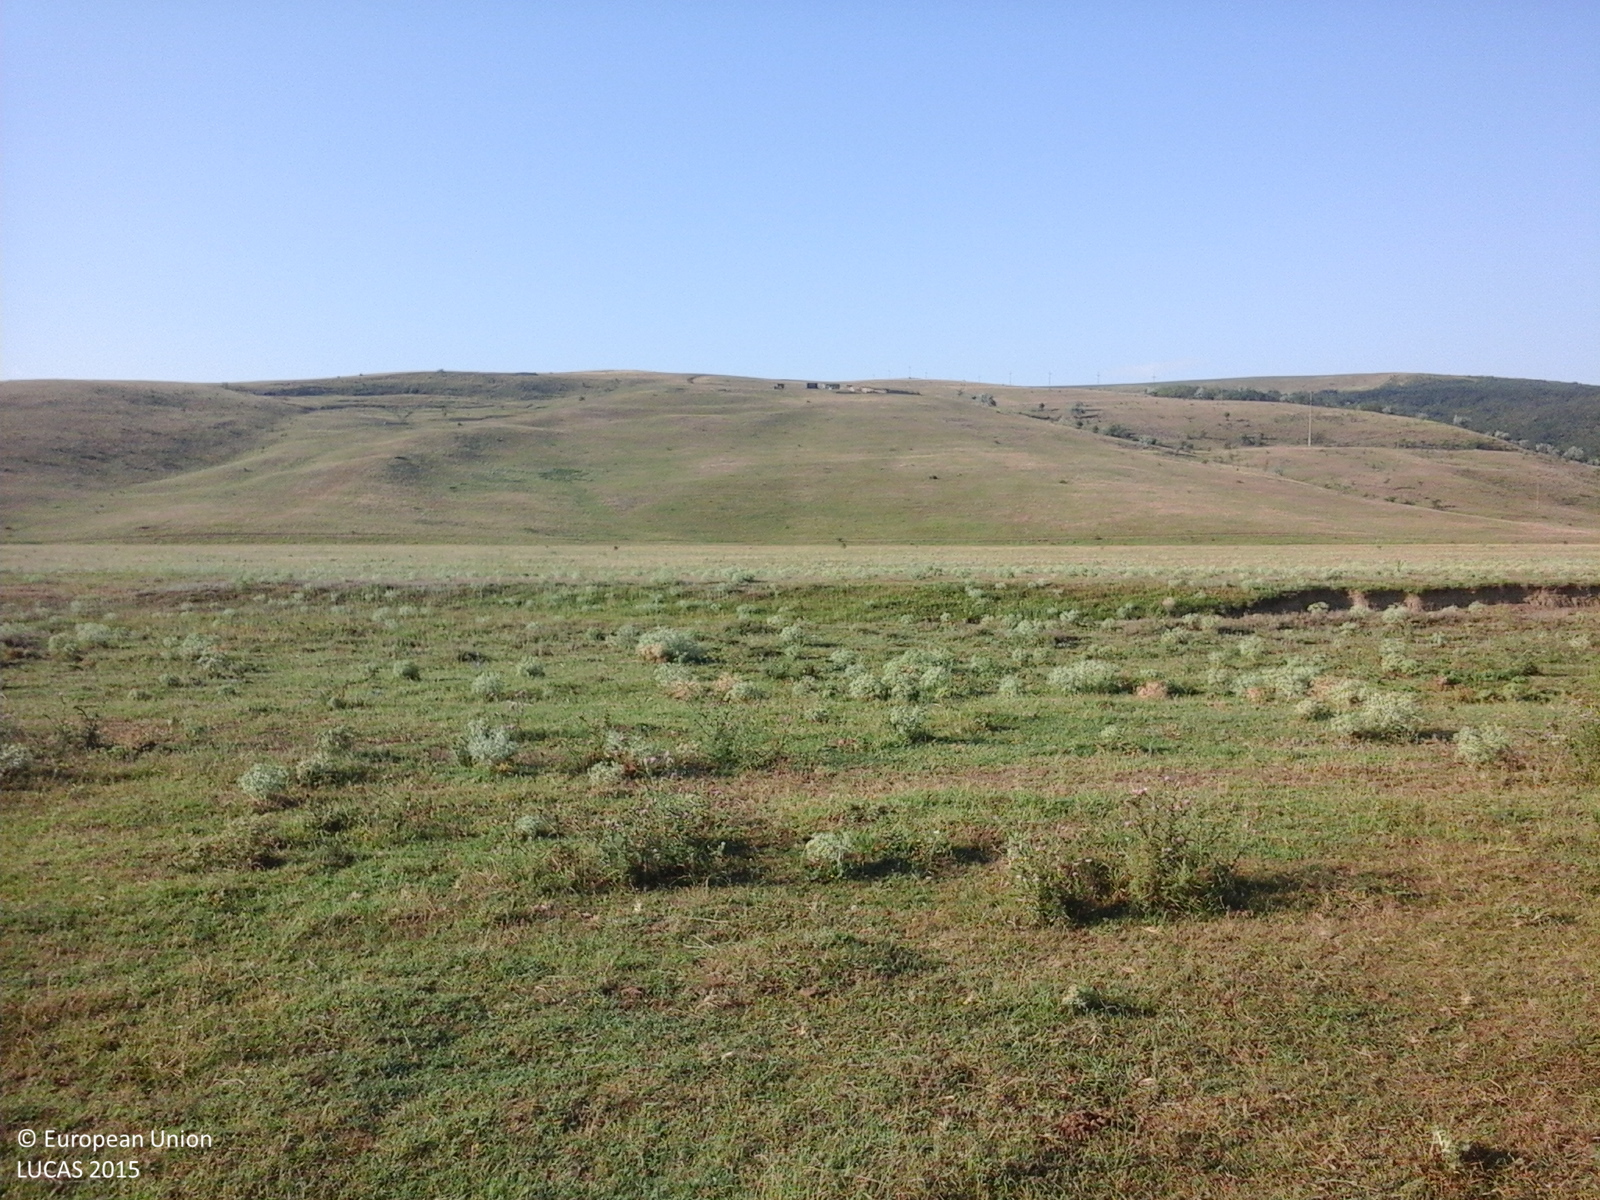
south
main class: Grassland
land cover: Grassland without tree/shrub cover
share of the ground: > 75 %
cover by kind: herbaceous plants 100 %
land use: Agriculture (excluding fallow land and kitchen gardens)
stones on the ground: < 10 %
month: July
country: RO
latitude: 46.1827
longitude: 27.7210
